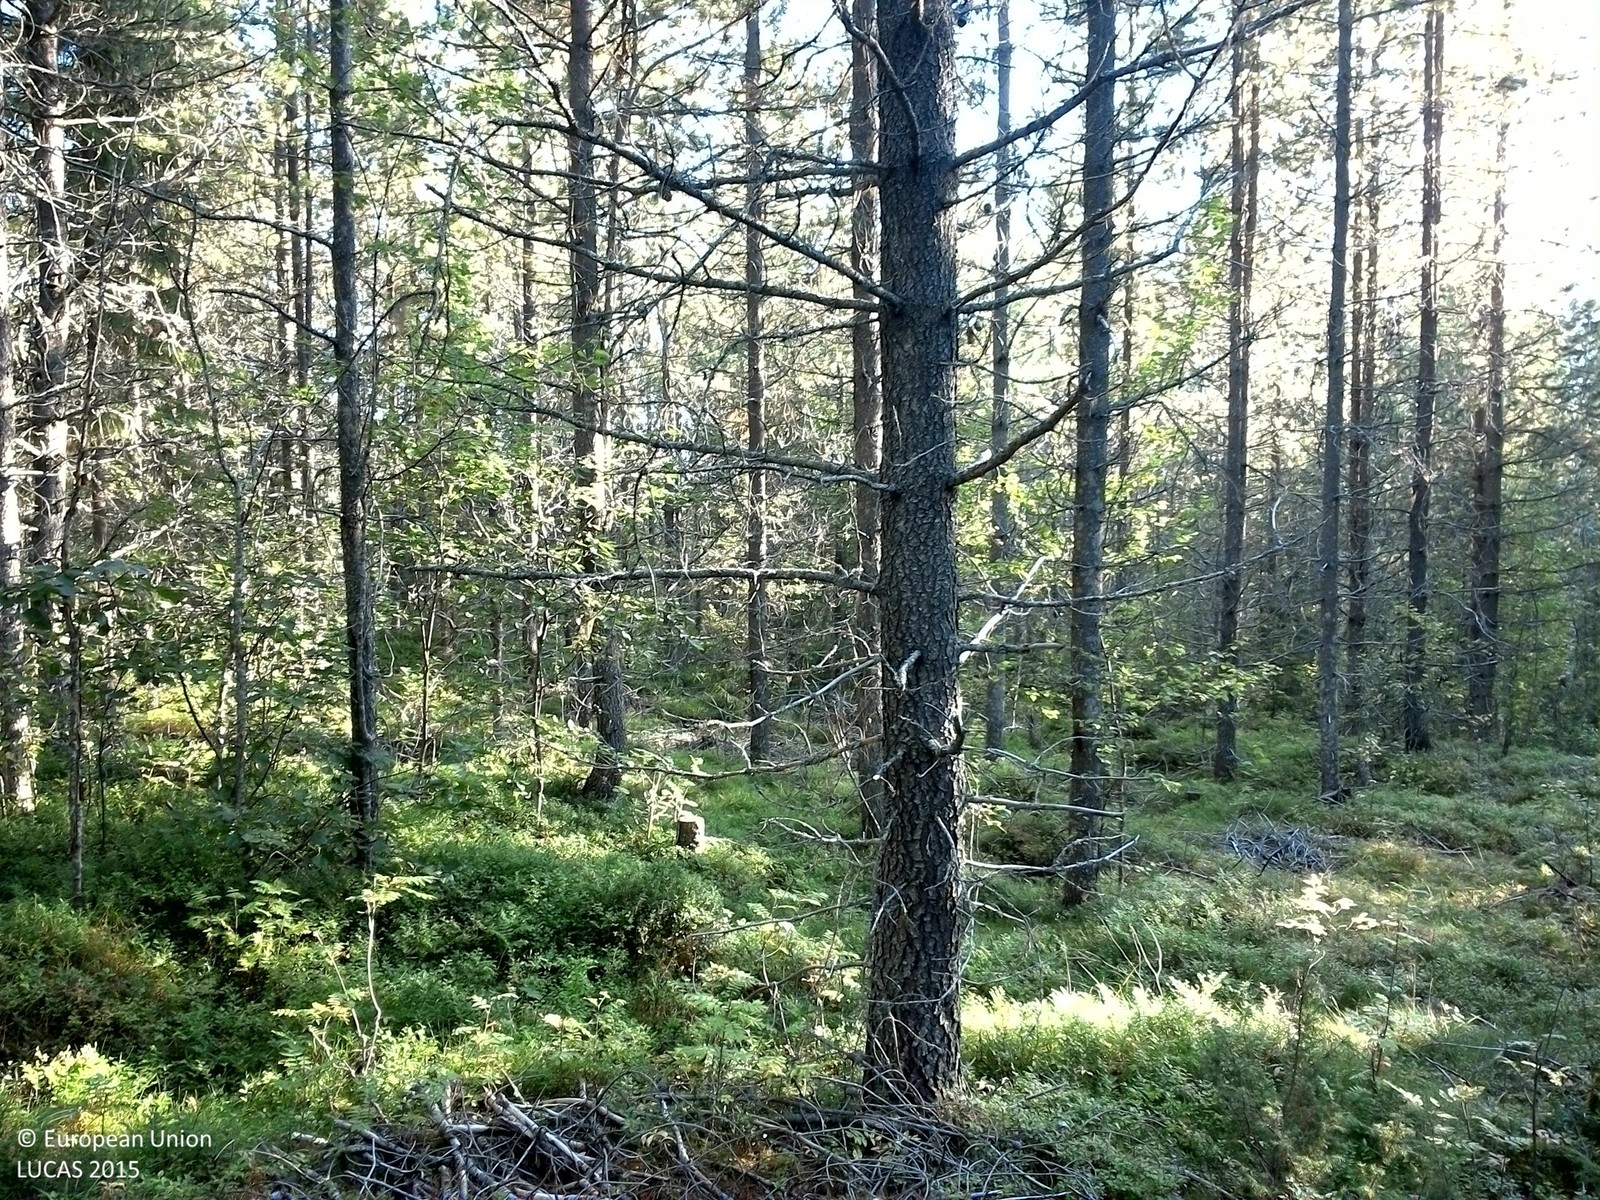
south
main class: Woodland
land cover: Pine dominated coniferous woodland
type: exotic forest
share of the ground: 50 - 75 %
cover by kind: coniferous forest trees 50 %, shrubs 30 %, broadleaved forest trees 10 %, lichens and mosses 10 %
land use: Forestry
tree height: > 5 m
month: September
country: SE
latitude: 63.8790
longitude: 16.6285
